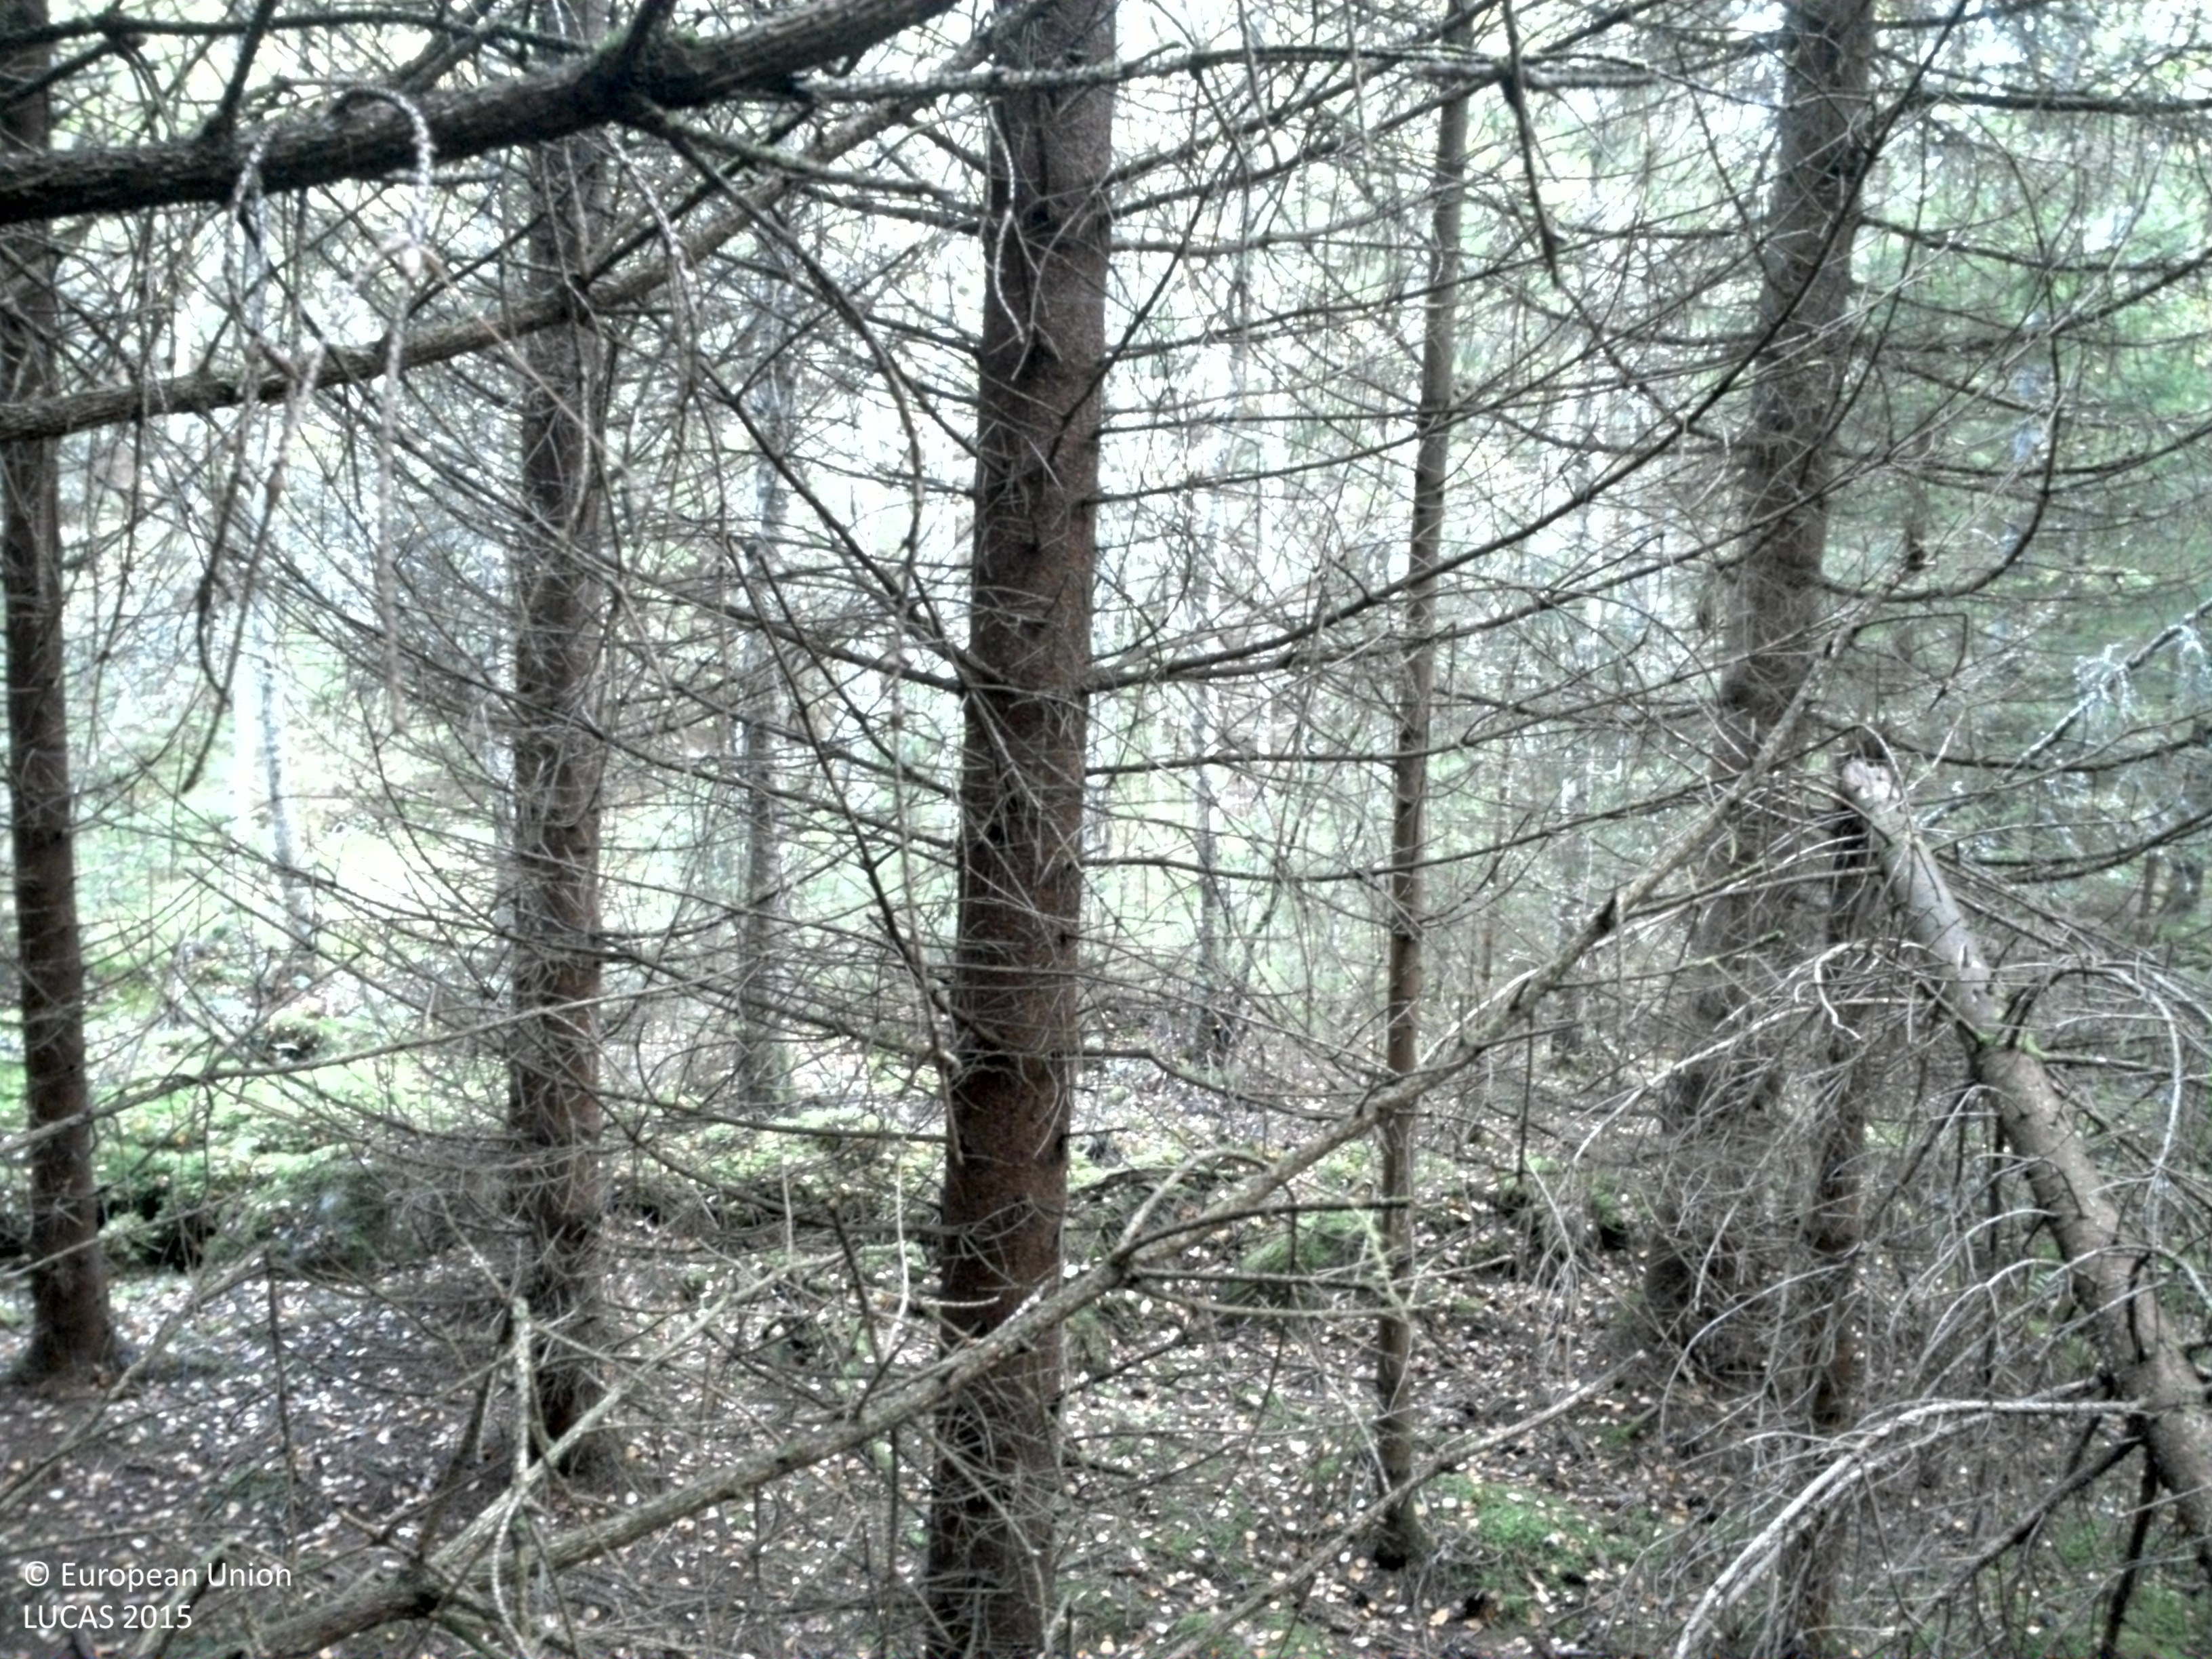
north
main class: Woodland
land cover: Spruce dominated coniferous woodland
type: boreal forest
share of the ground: > 75 %
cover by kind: coniferous forest trees 95 %, lichens and mosses 5 %
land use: Forestry
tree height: > 5 m
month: September
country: SE
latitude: 57.9102
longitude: 13.2523
